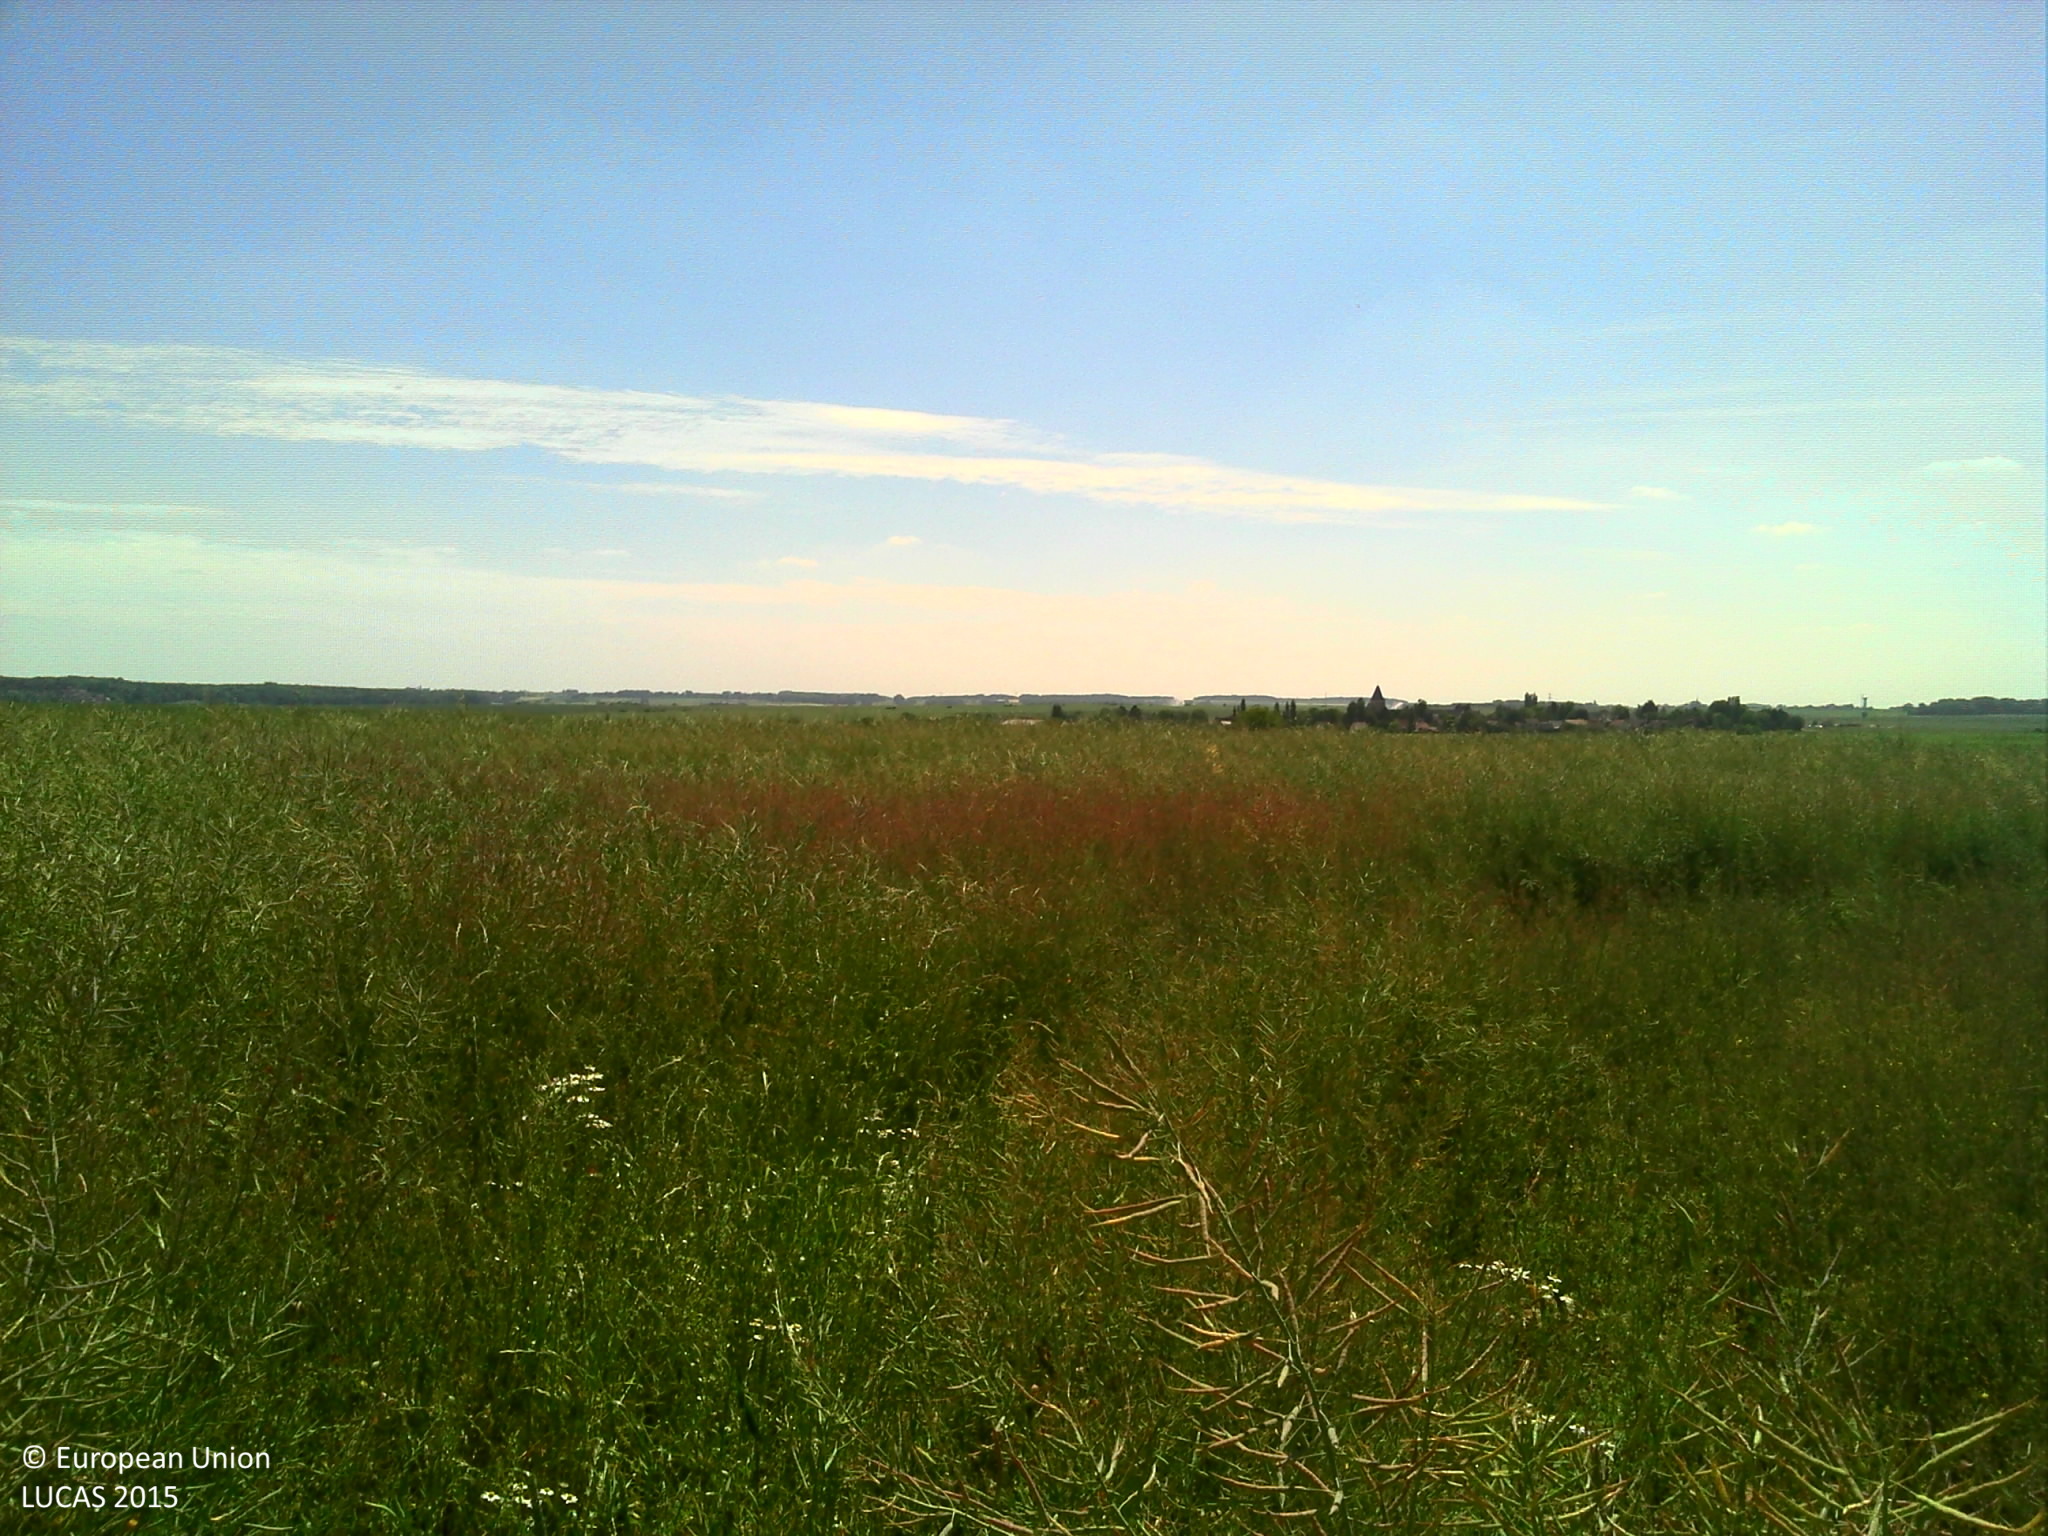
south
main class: Cropland
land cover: Rape and turnip rape
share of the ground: > 75 %
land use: Agriculture (excluding fallow land and kitchen gardens)
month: June
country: FR
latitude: 49.5065
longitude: 2.5447
